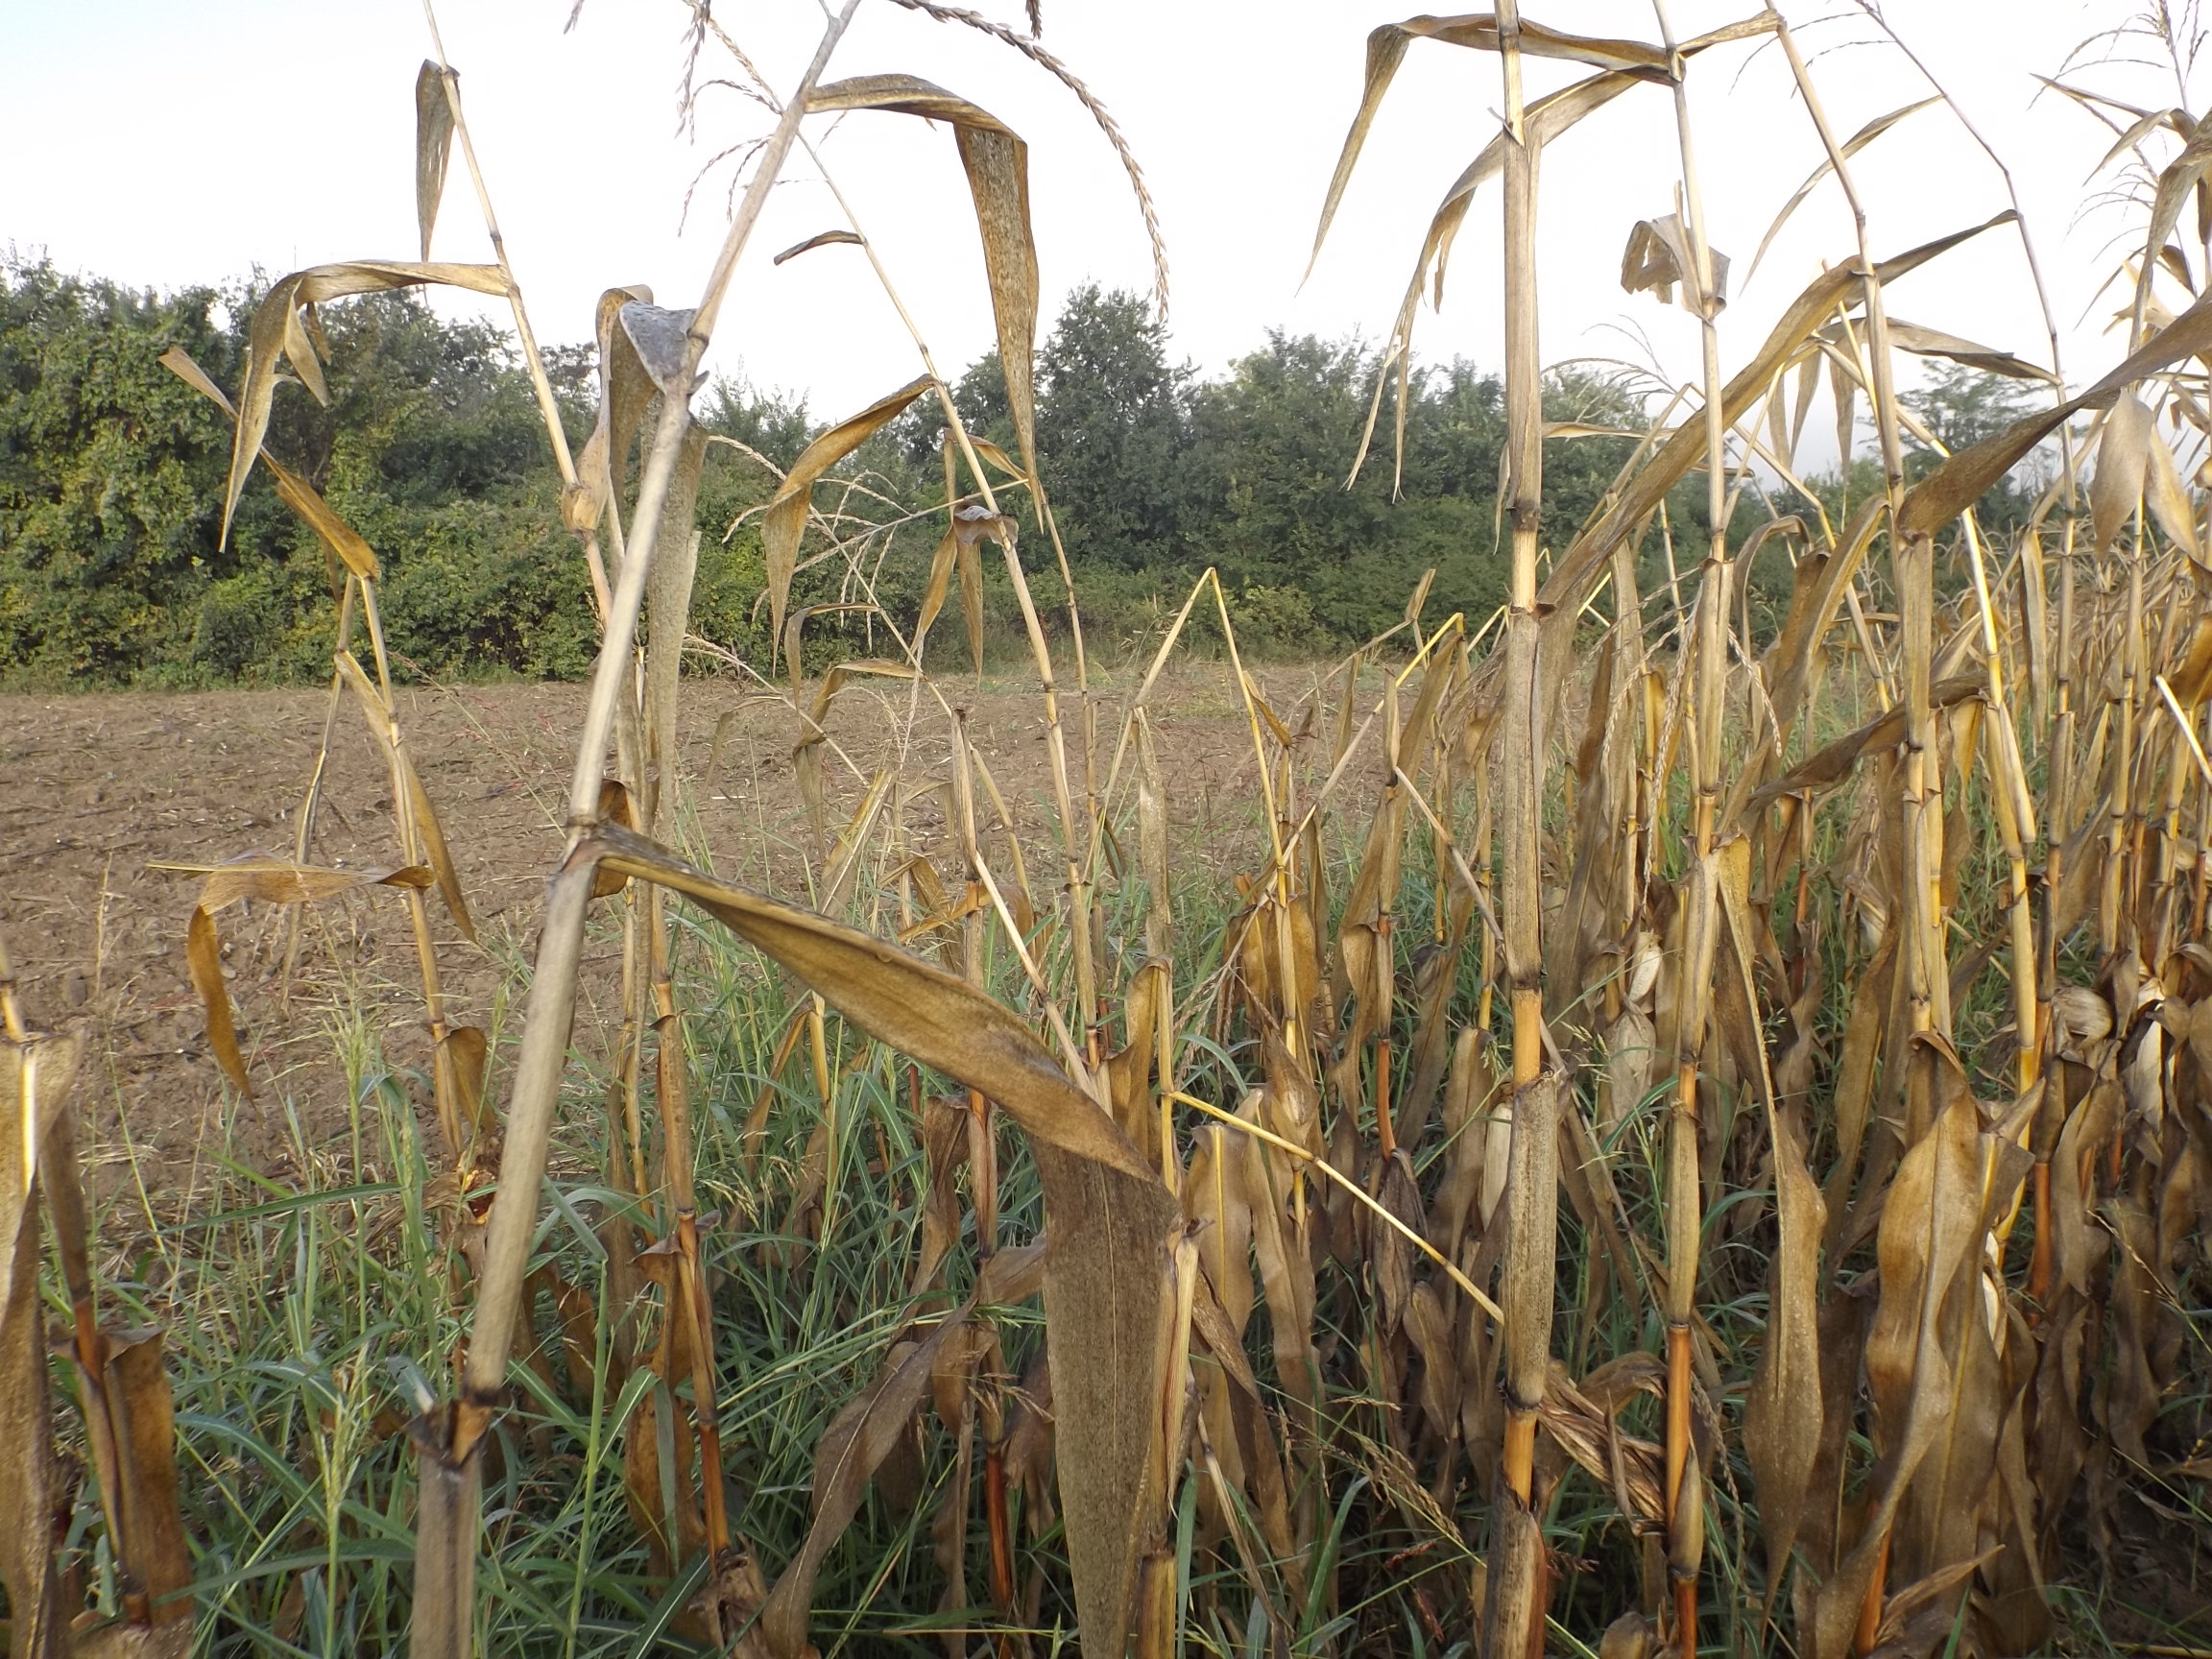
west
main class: Cropland
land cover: Maize
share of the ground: > 75 %
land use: Agriculture (excluding fallow land and kitchen gardens)
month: September
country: BG
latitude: 44.0227
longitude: 26.5420
